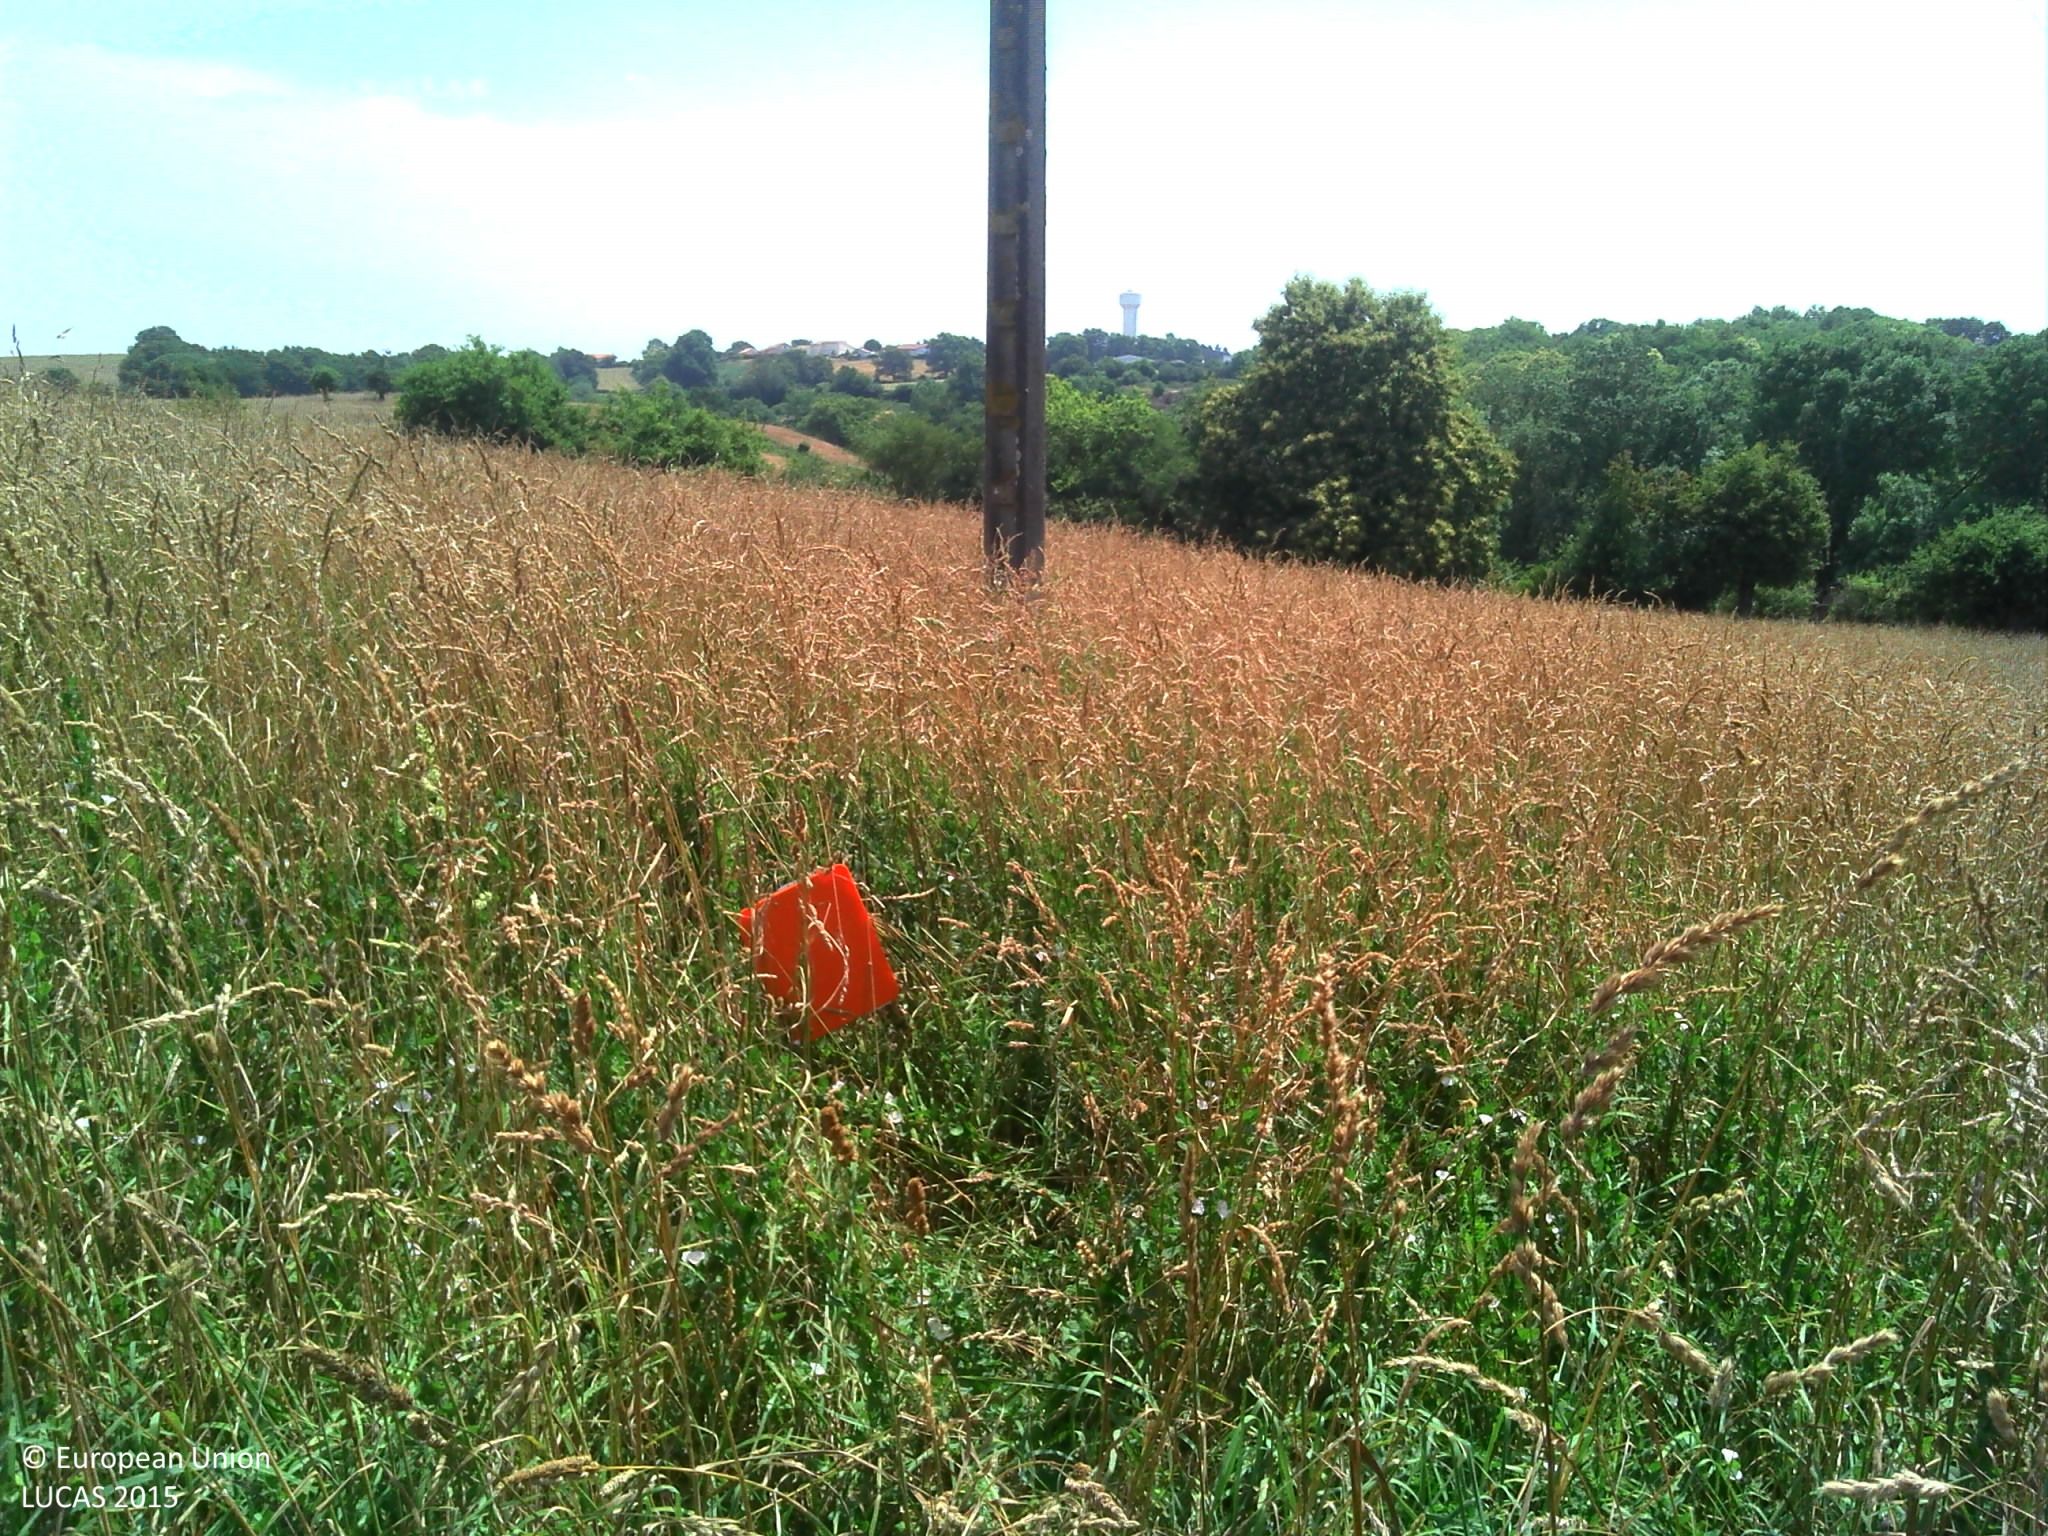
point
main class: Grassland
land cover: Grassland without tree/shrub cover
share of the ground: > 75 %
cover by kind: herbaceous plants 100 %
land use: Agriculture (excluding fallow land and kitchen gardens)
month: July
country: FR
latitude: 46.9728
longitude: -0.9036
